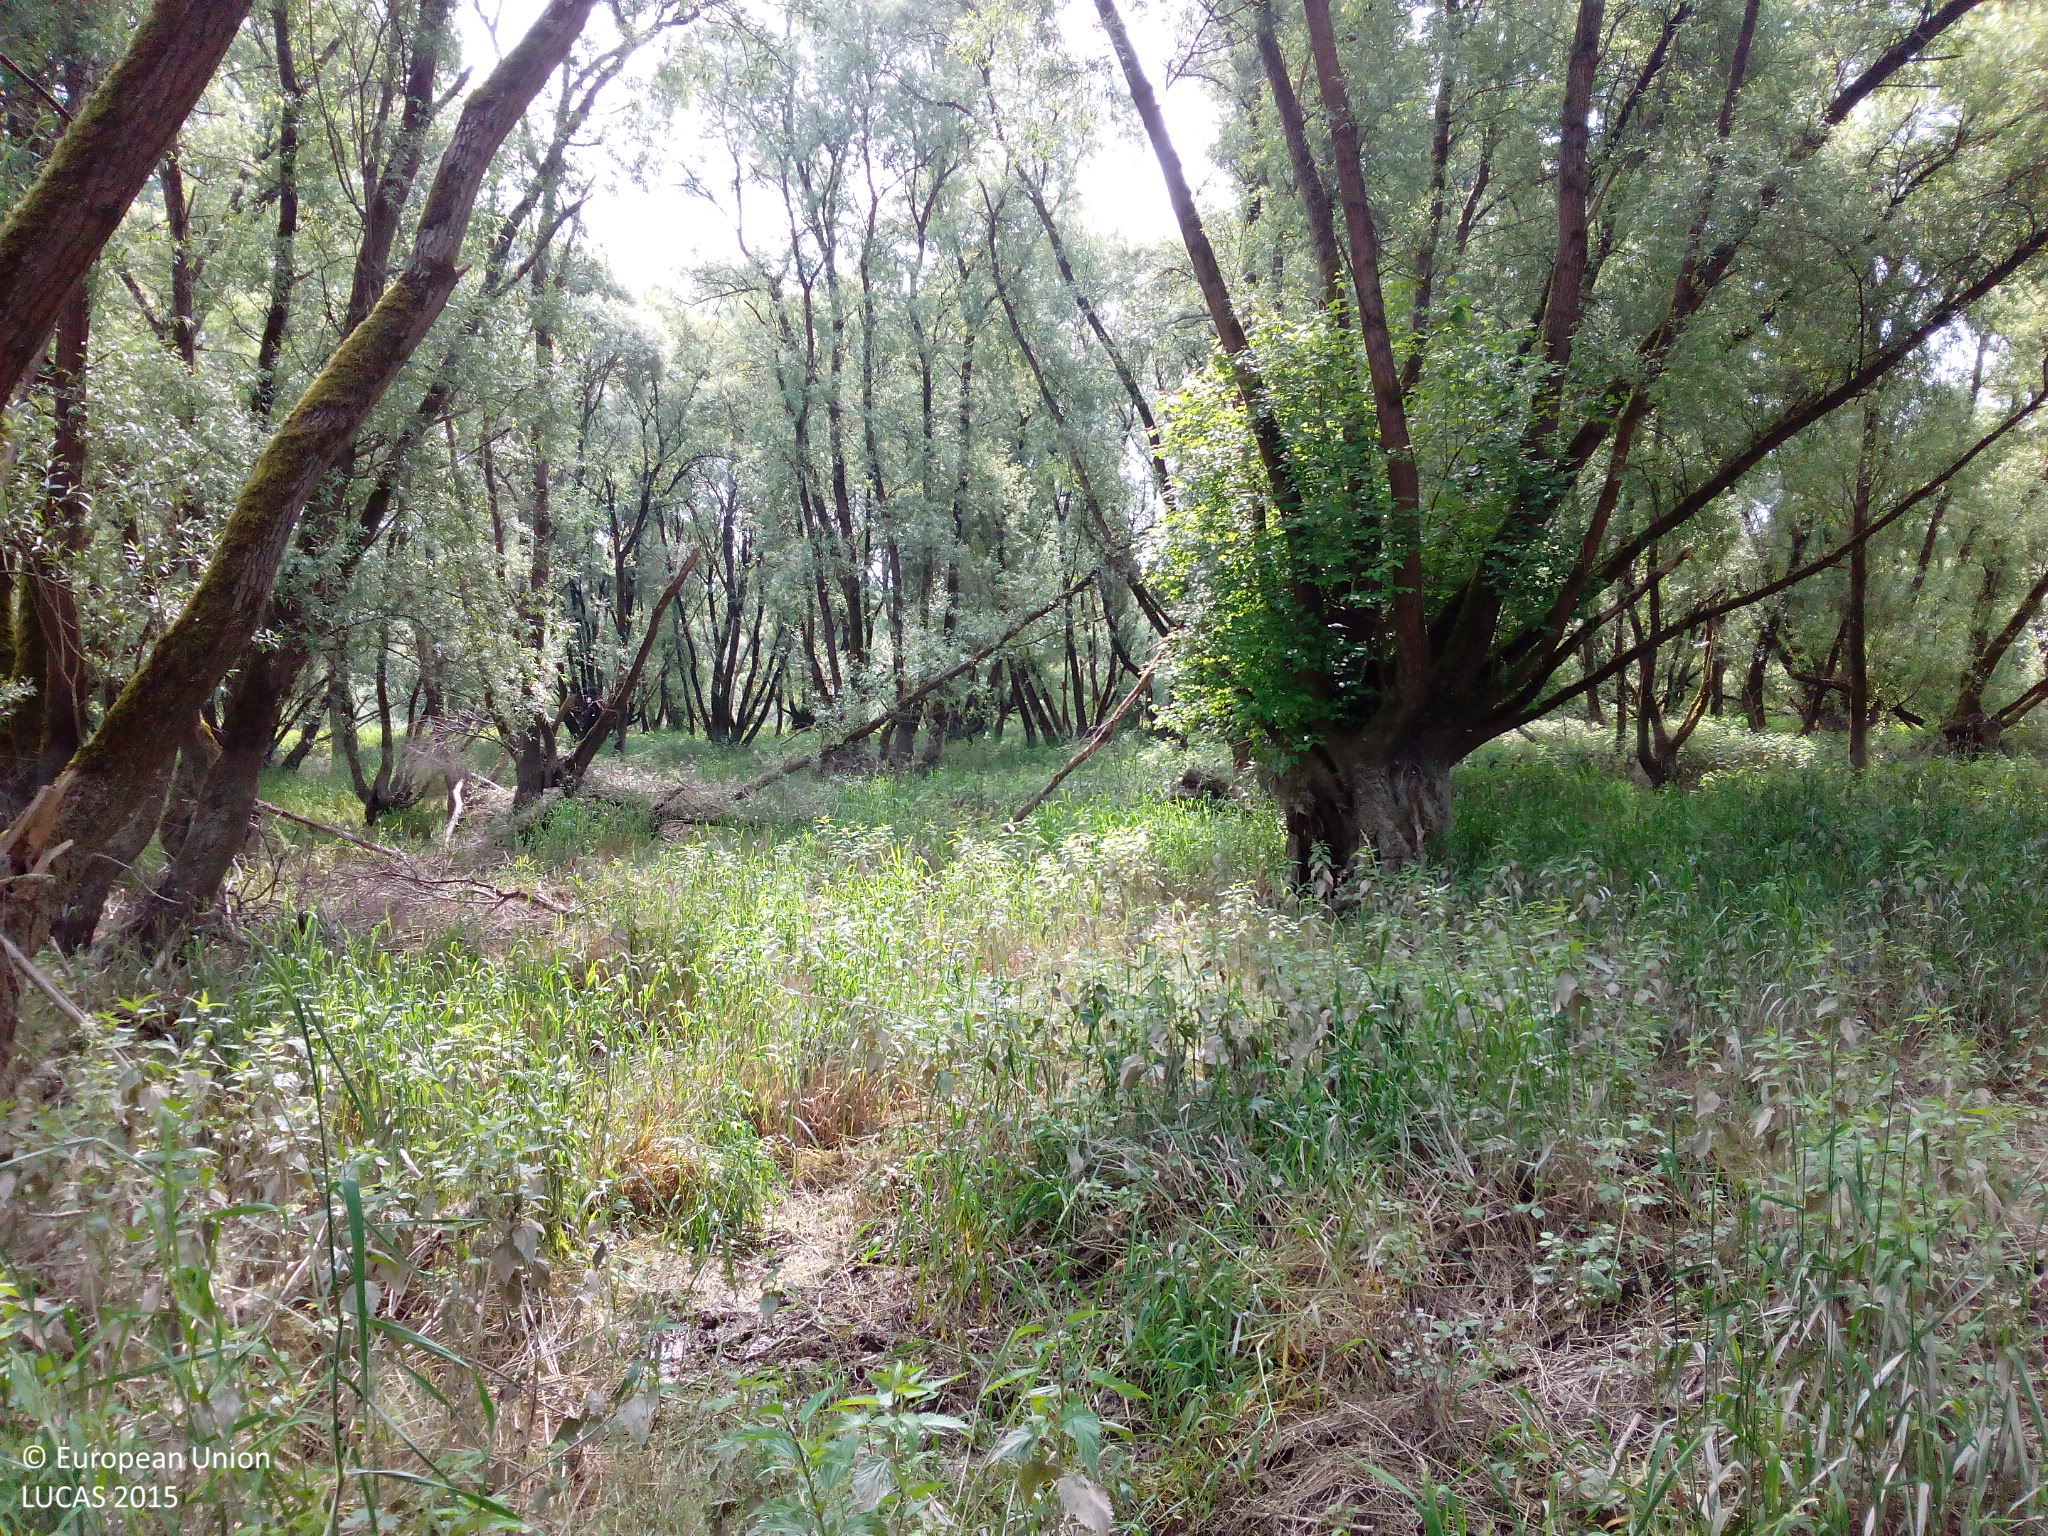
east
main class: Woodland
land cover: Broadleaved woodland
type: floodplain forest
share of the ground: 25 - 50 %
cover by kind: broadleaved forest trees 60 %, herbaceous plants 20 %, unconsolidated bare surface 20 %
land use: Semi-natural and natural areas not in use
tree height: > 5 m
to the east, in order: Broadleaved woodland; Tracks; Broadleaved woodland; Spontaneously vegetated surfaces; Broadleaved woodland
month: May
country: DE
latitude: 48.9100
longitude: 8.1587
